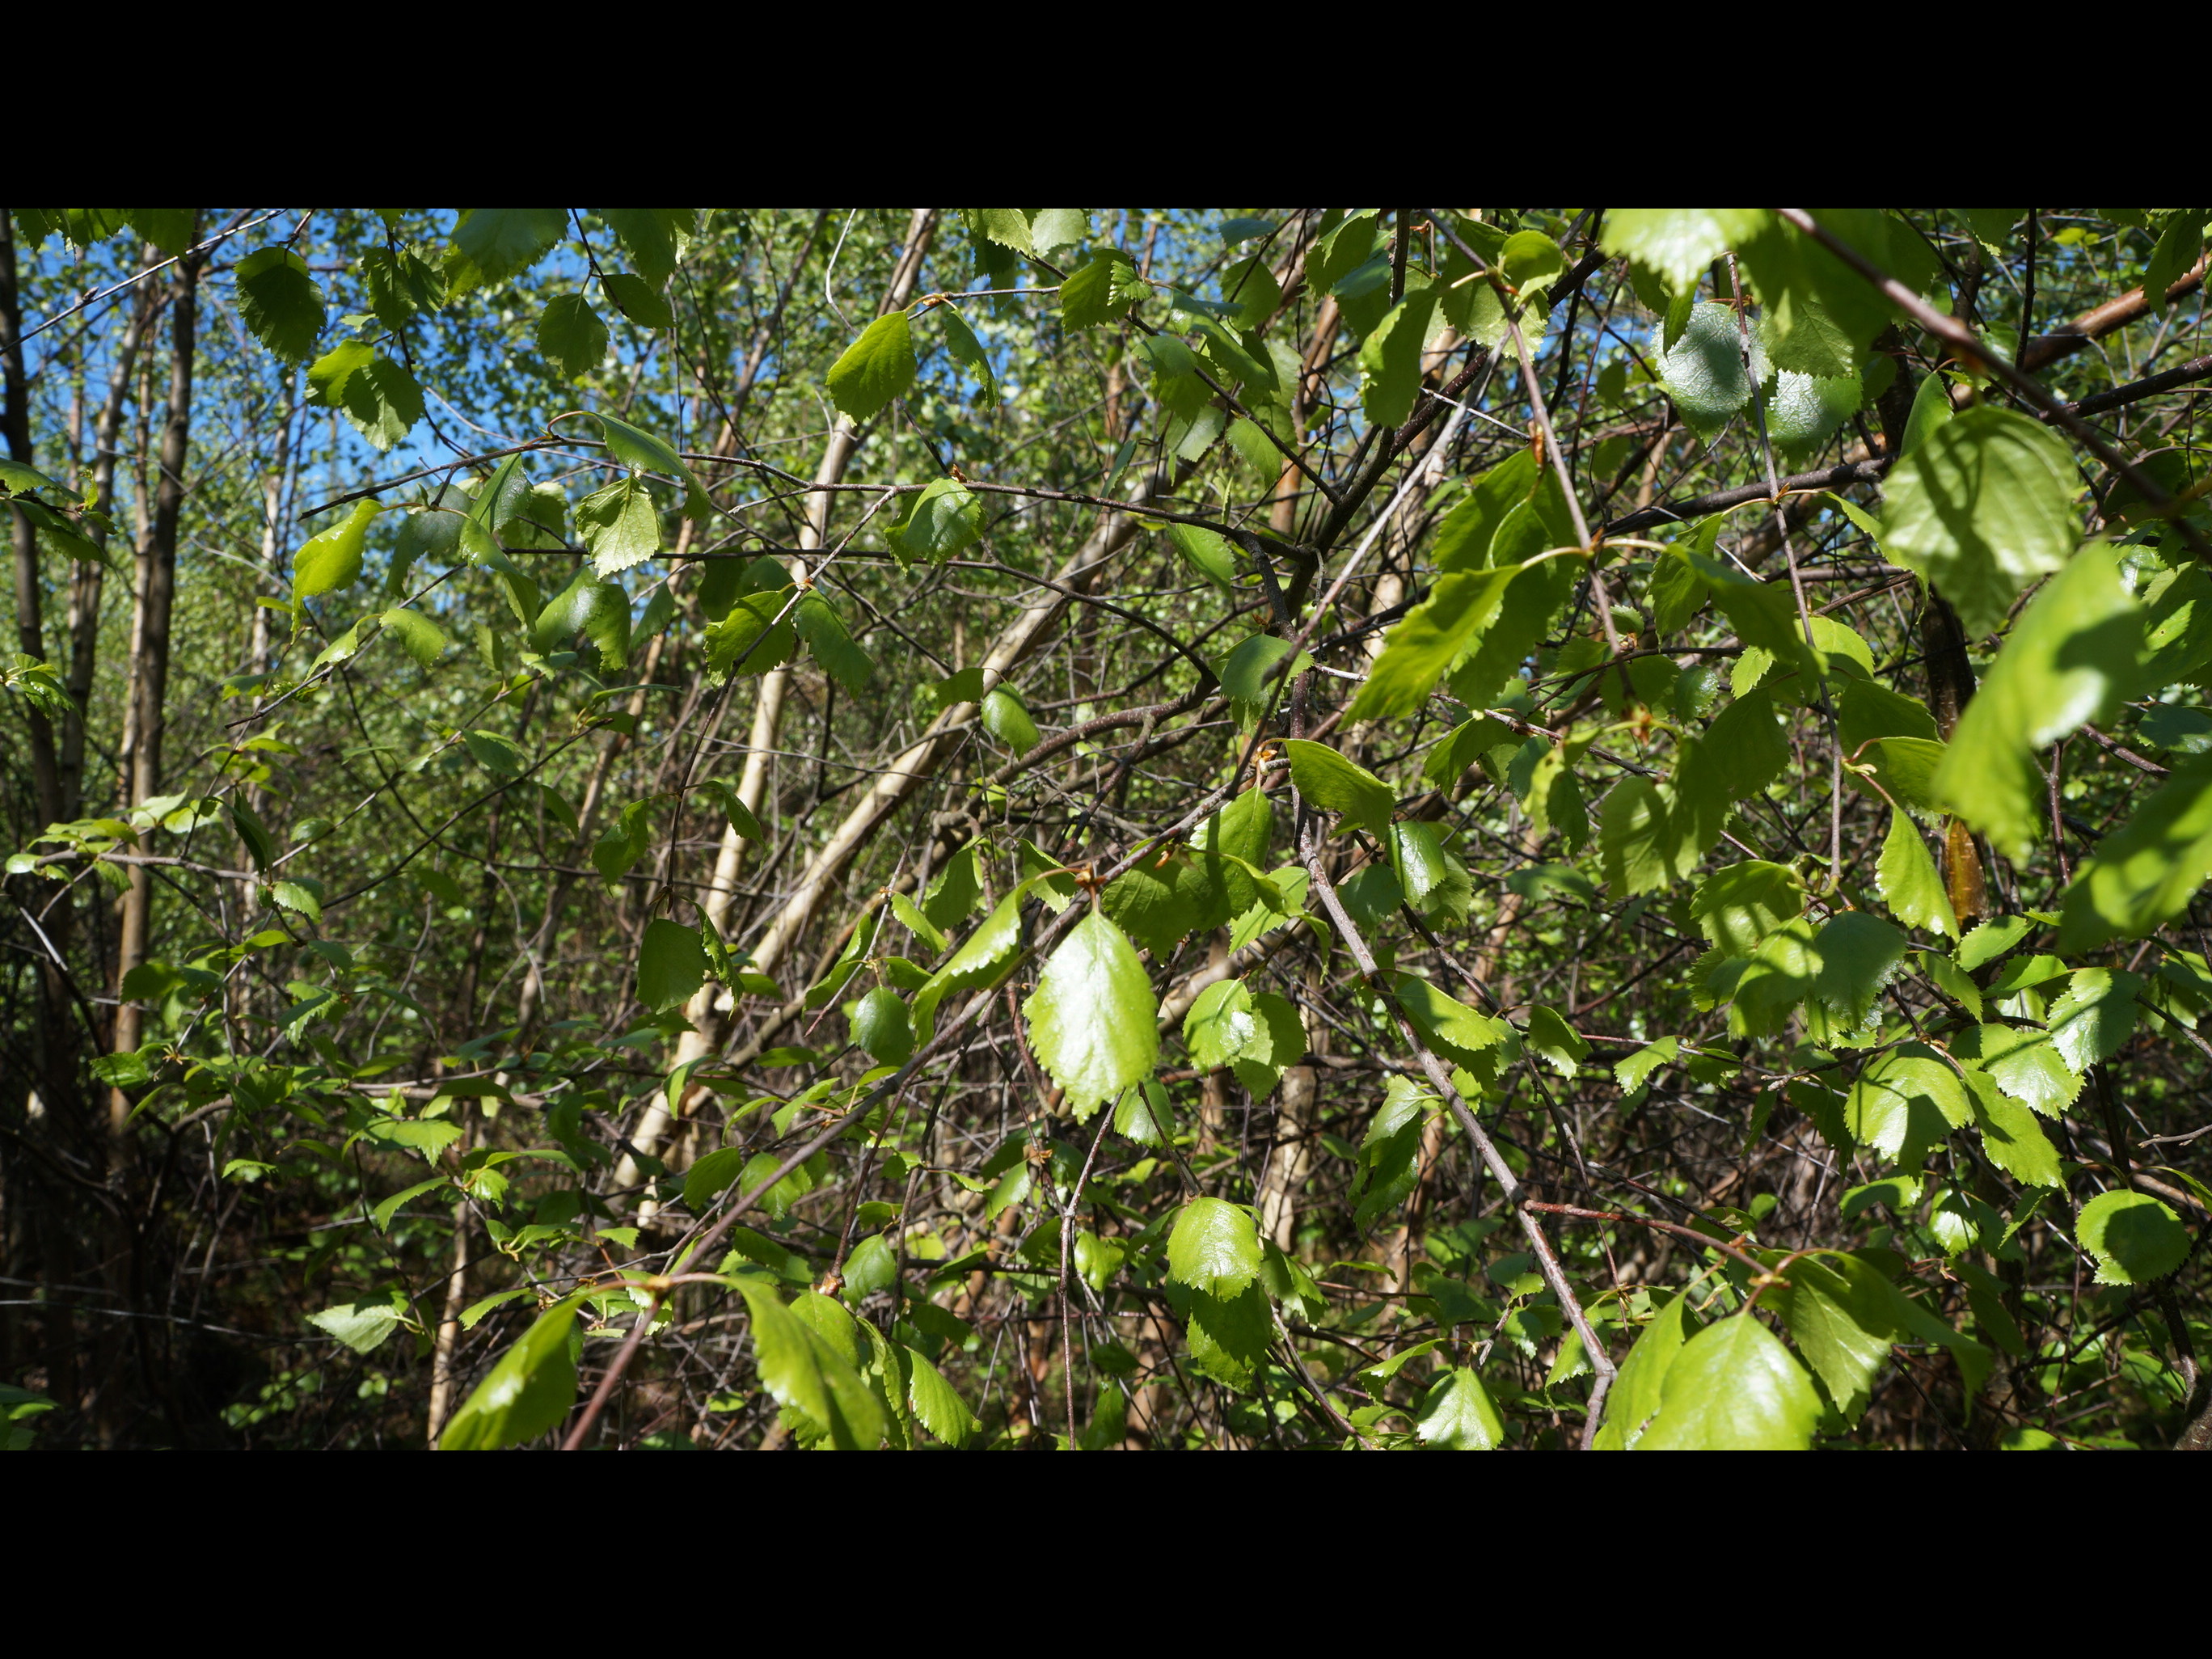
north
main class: Woodland
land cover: Broadleaved woodland
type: boreal forest
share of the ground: > 75 %
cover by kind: broadleaved forest trees 85 %, herbaceous plants 10 %, coniferous forest trees 5 %
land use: Forestry
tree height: < 5 m
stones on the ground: 10 - 25 %
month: June
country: FI
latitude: 64.2213
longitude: 23.9317
